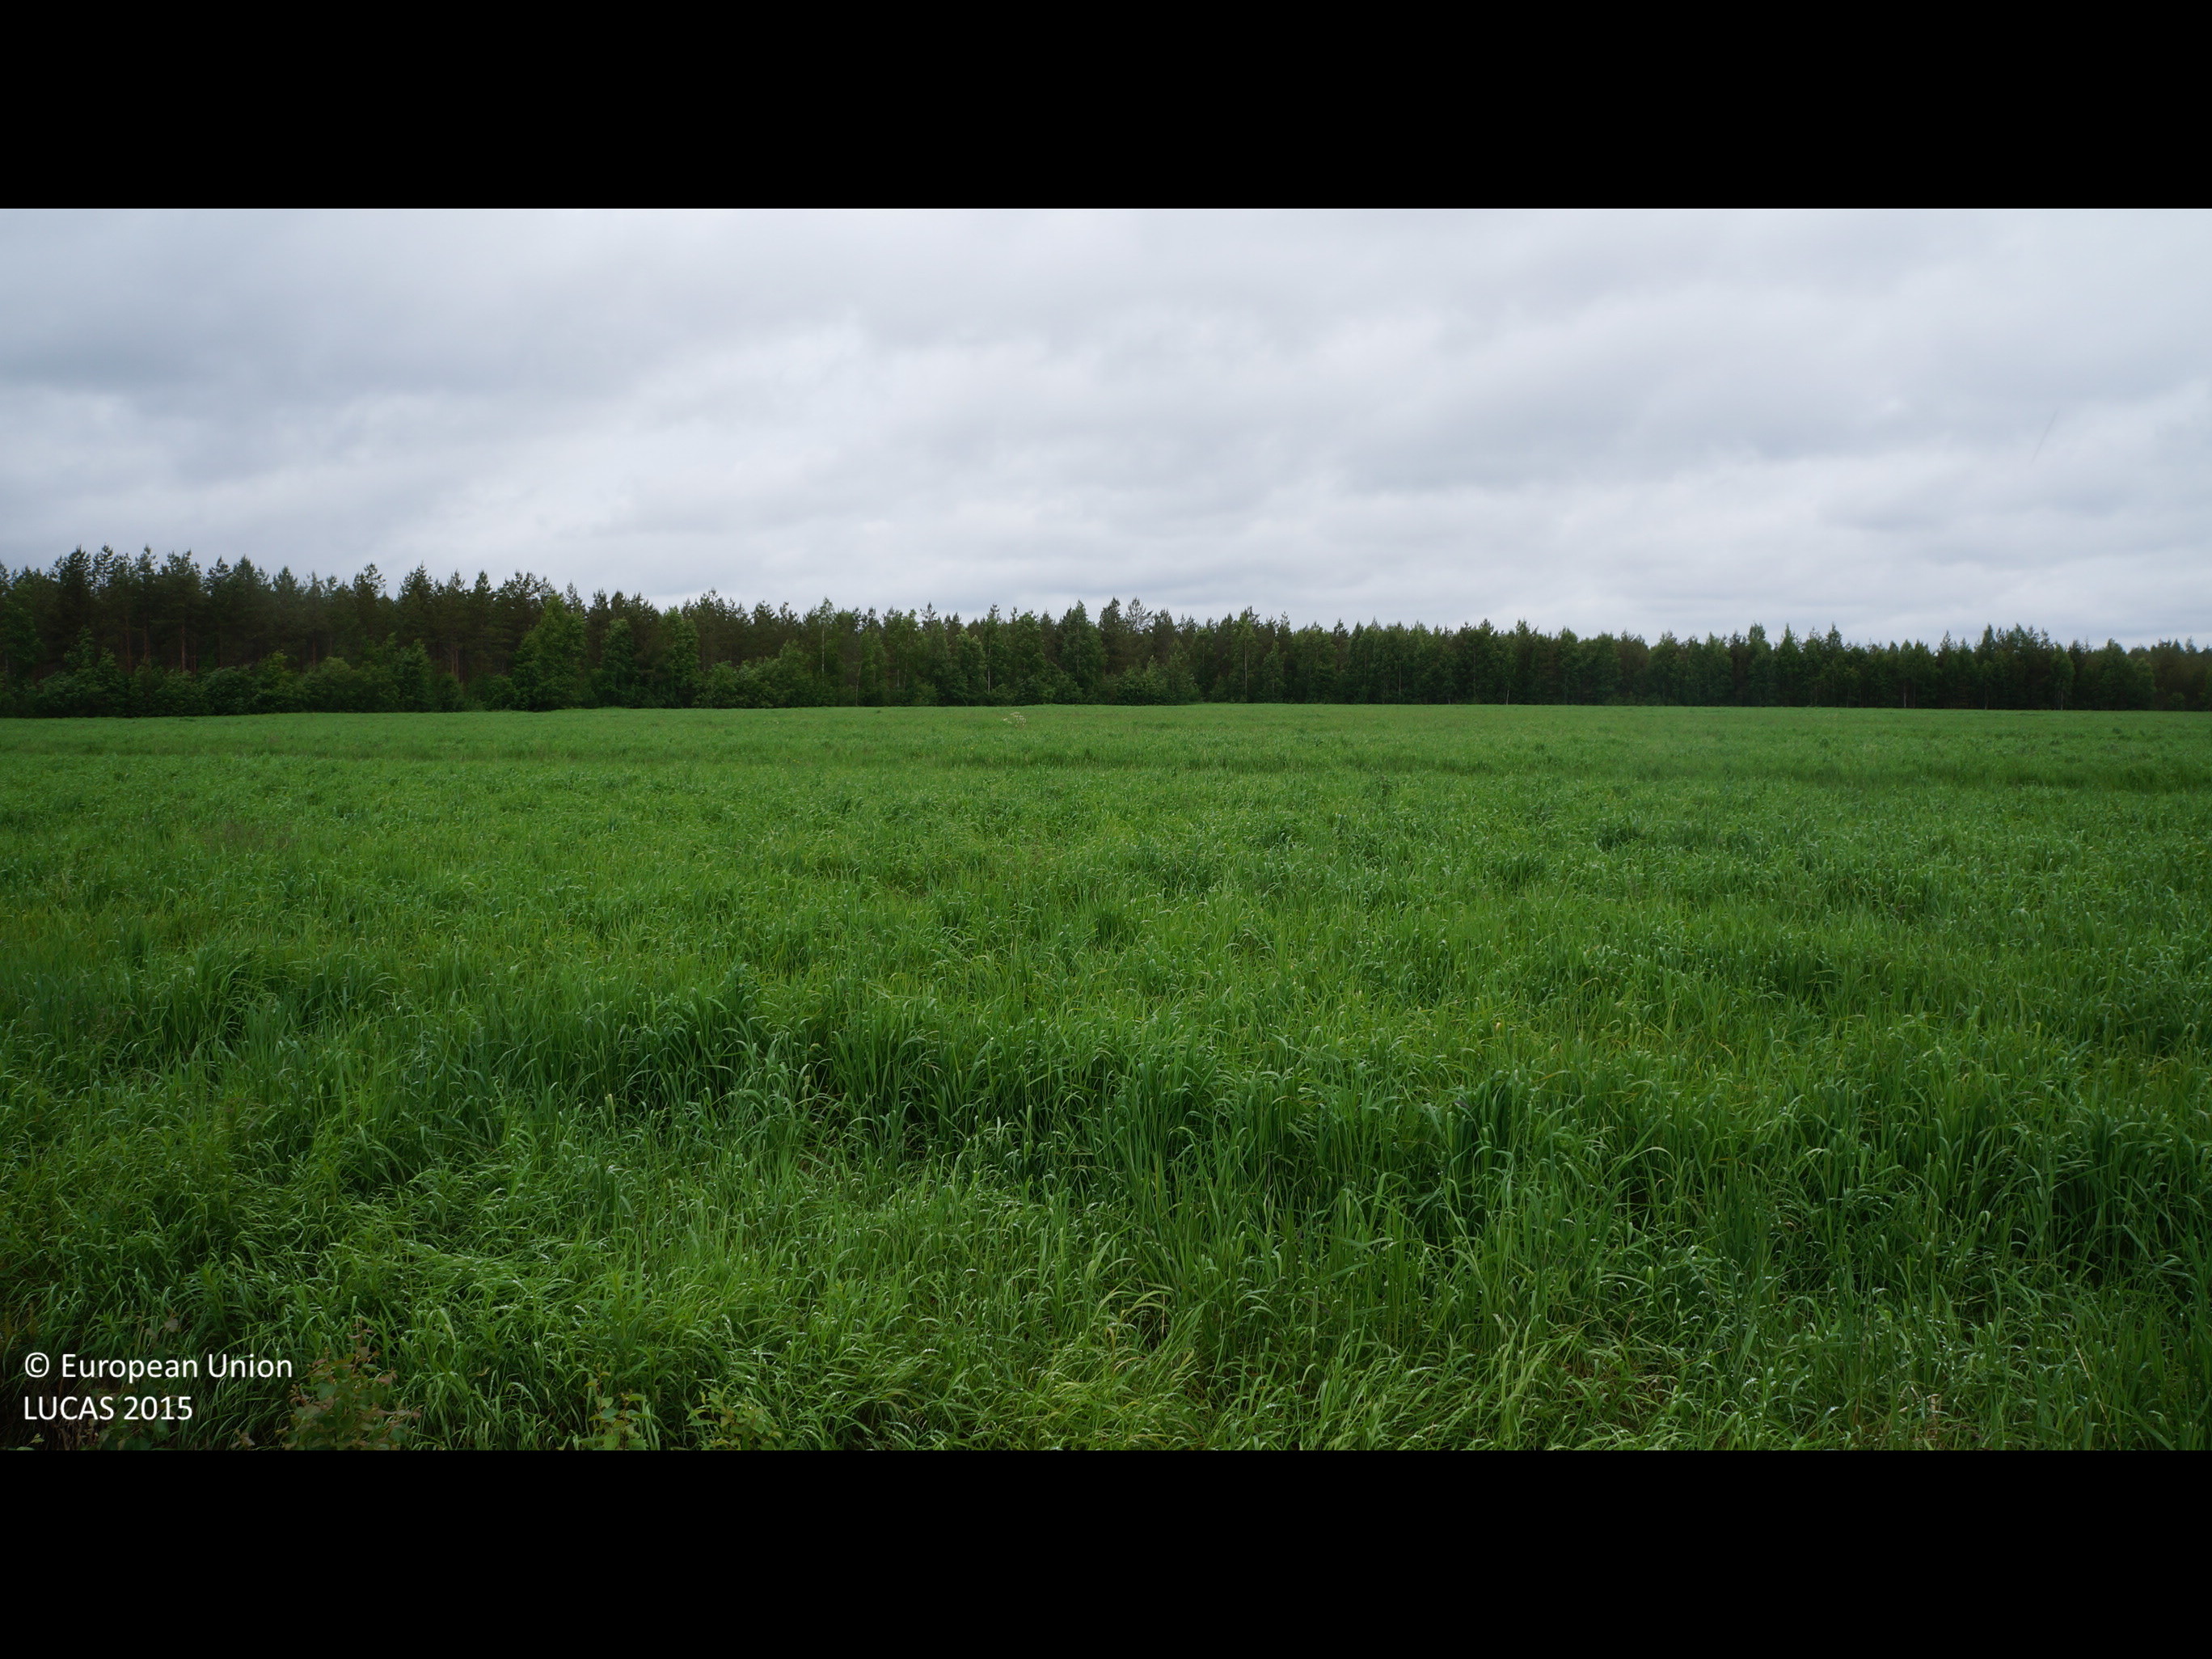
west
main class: Cropland
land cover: Temporary grasslands
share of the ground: > 75 %
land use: Agriculture (excluding fallow land and kitchen gardens)
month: June
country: FI
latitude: 64.6612
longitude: 25.3513
